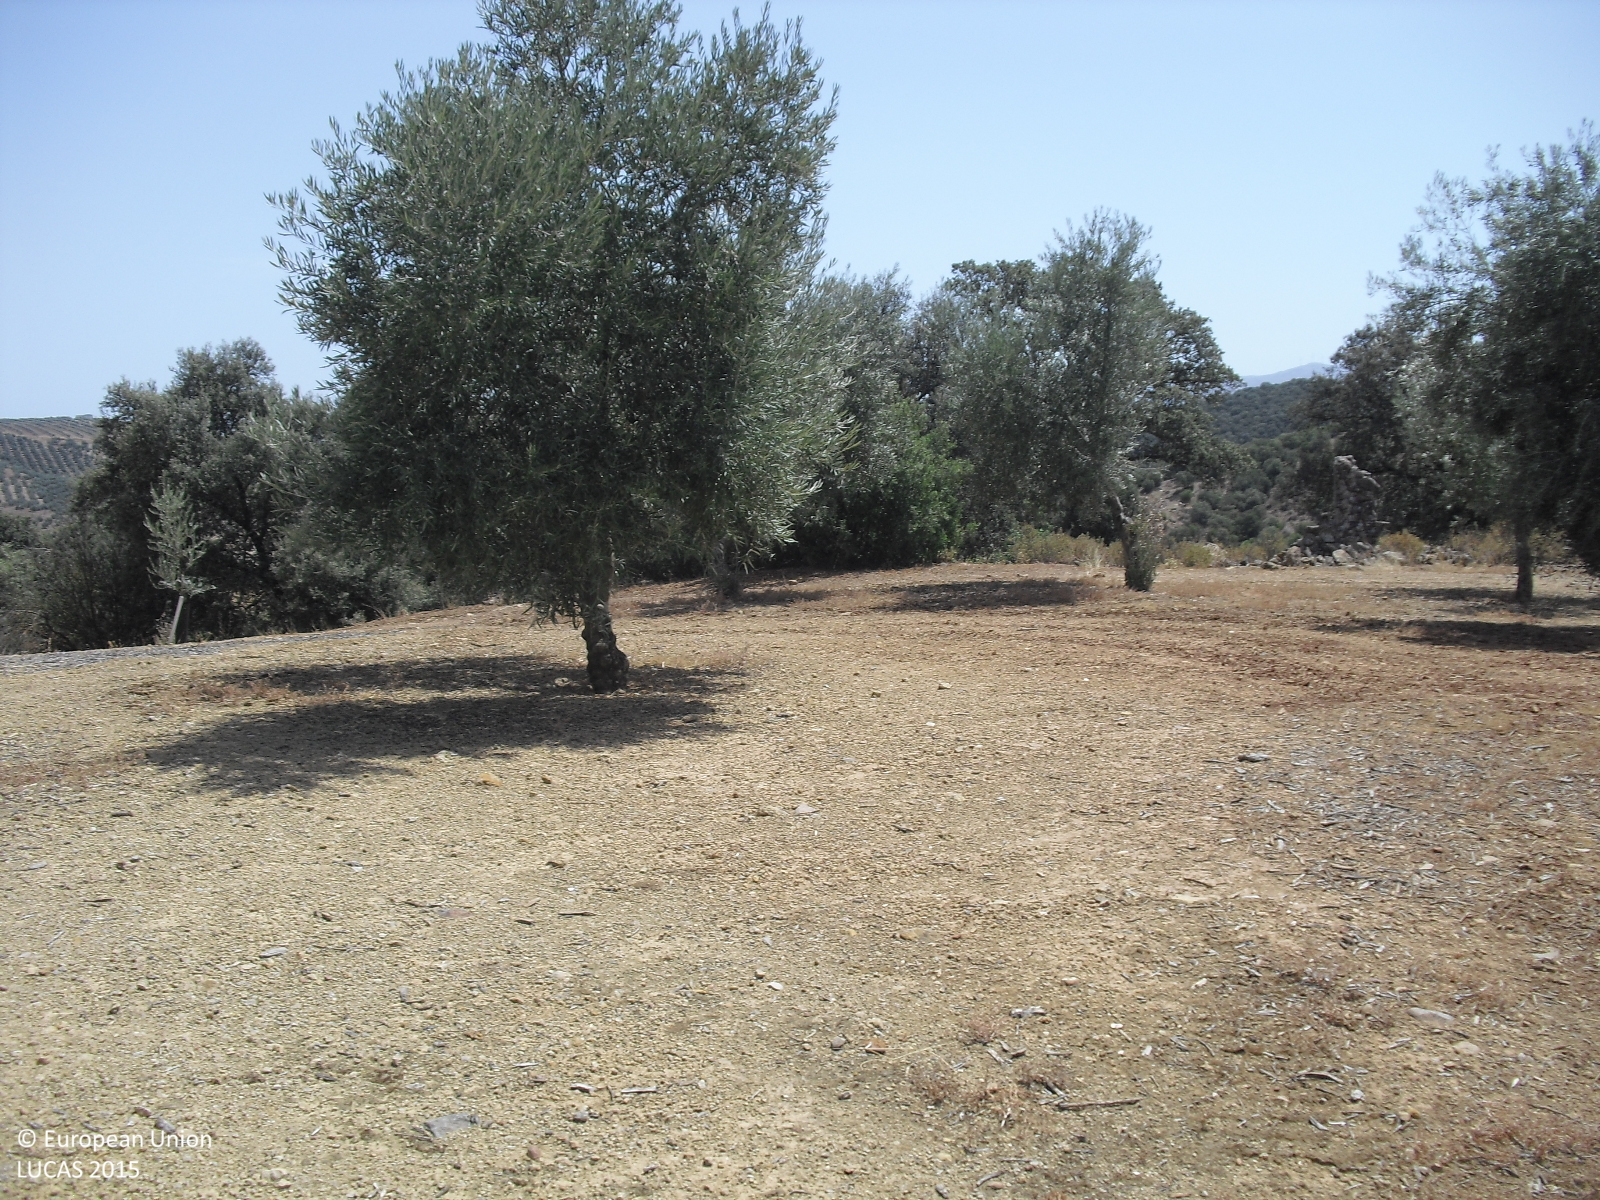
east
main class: Cropland
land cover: Olive groves
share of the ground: 10 - 25 %
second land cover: Other bare soil
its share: > 75 %
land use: Agriculture (excluding fallow land and kitchen gardens)
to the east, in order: Olive groves; Other bare soil; Broadleaved woodland; Other structural elements; Broadleaved woodland; Fences; Shrubland with sparse tree cover; Tracks; Broadleaved woodland; Rivers and streams
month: July
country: ES
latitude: 37.1738
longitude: -4.3114
